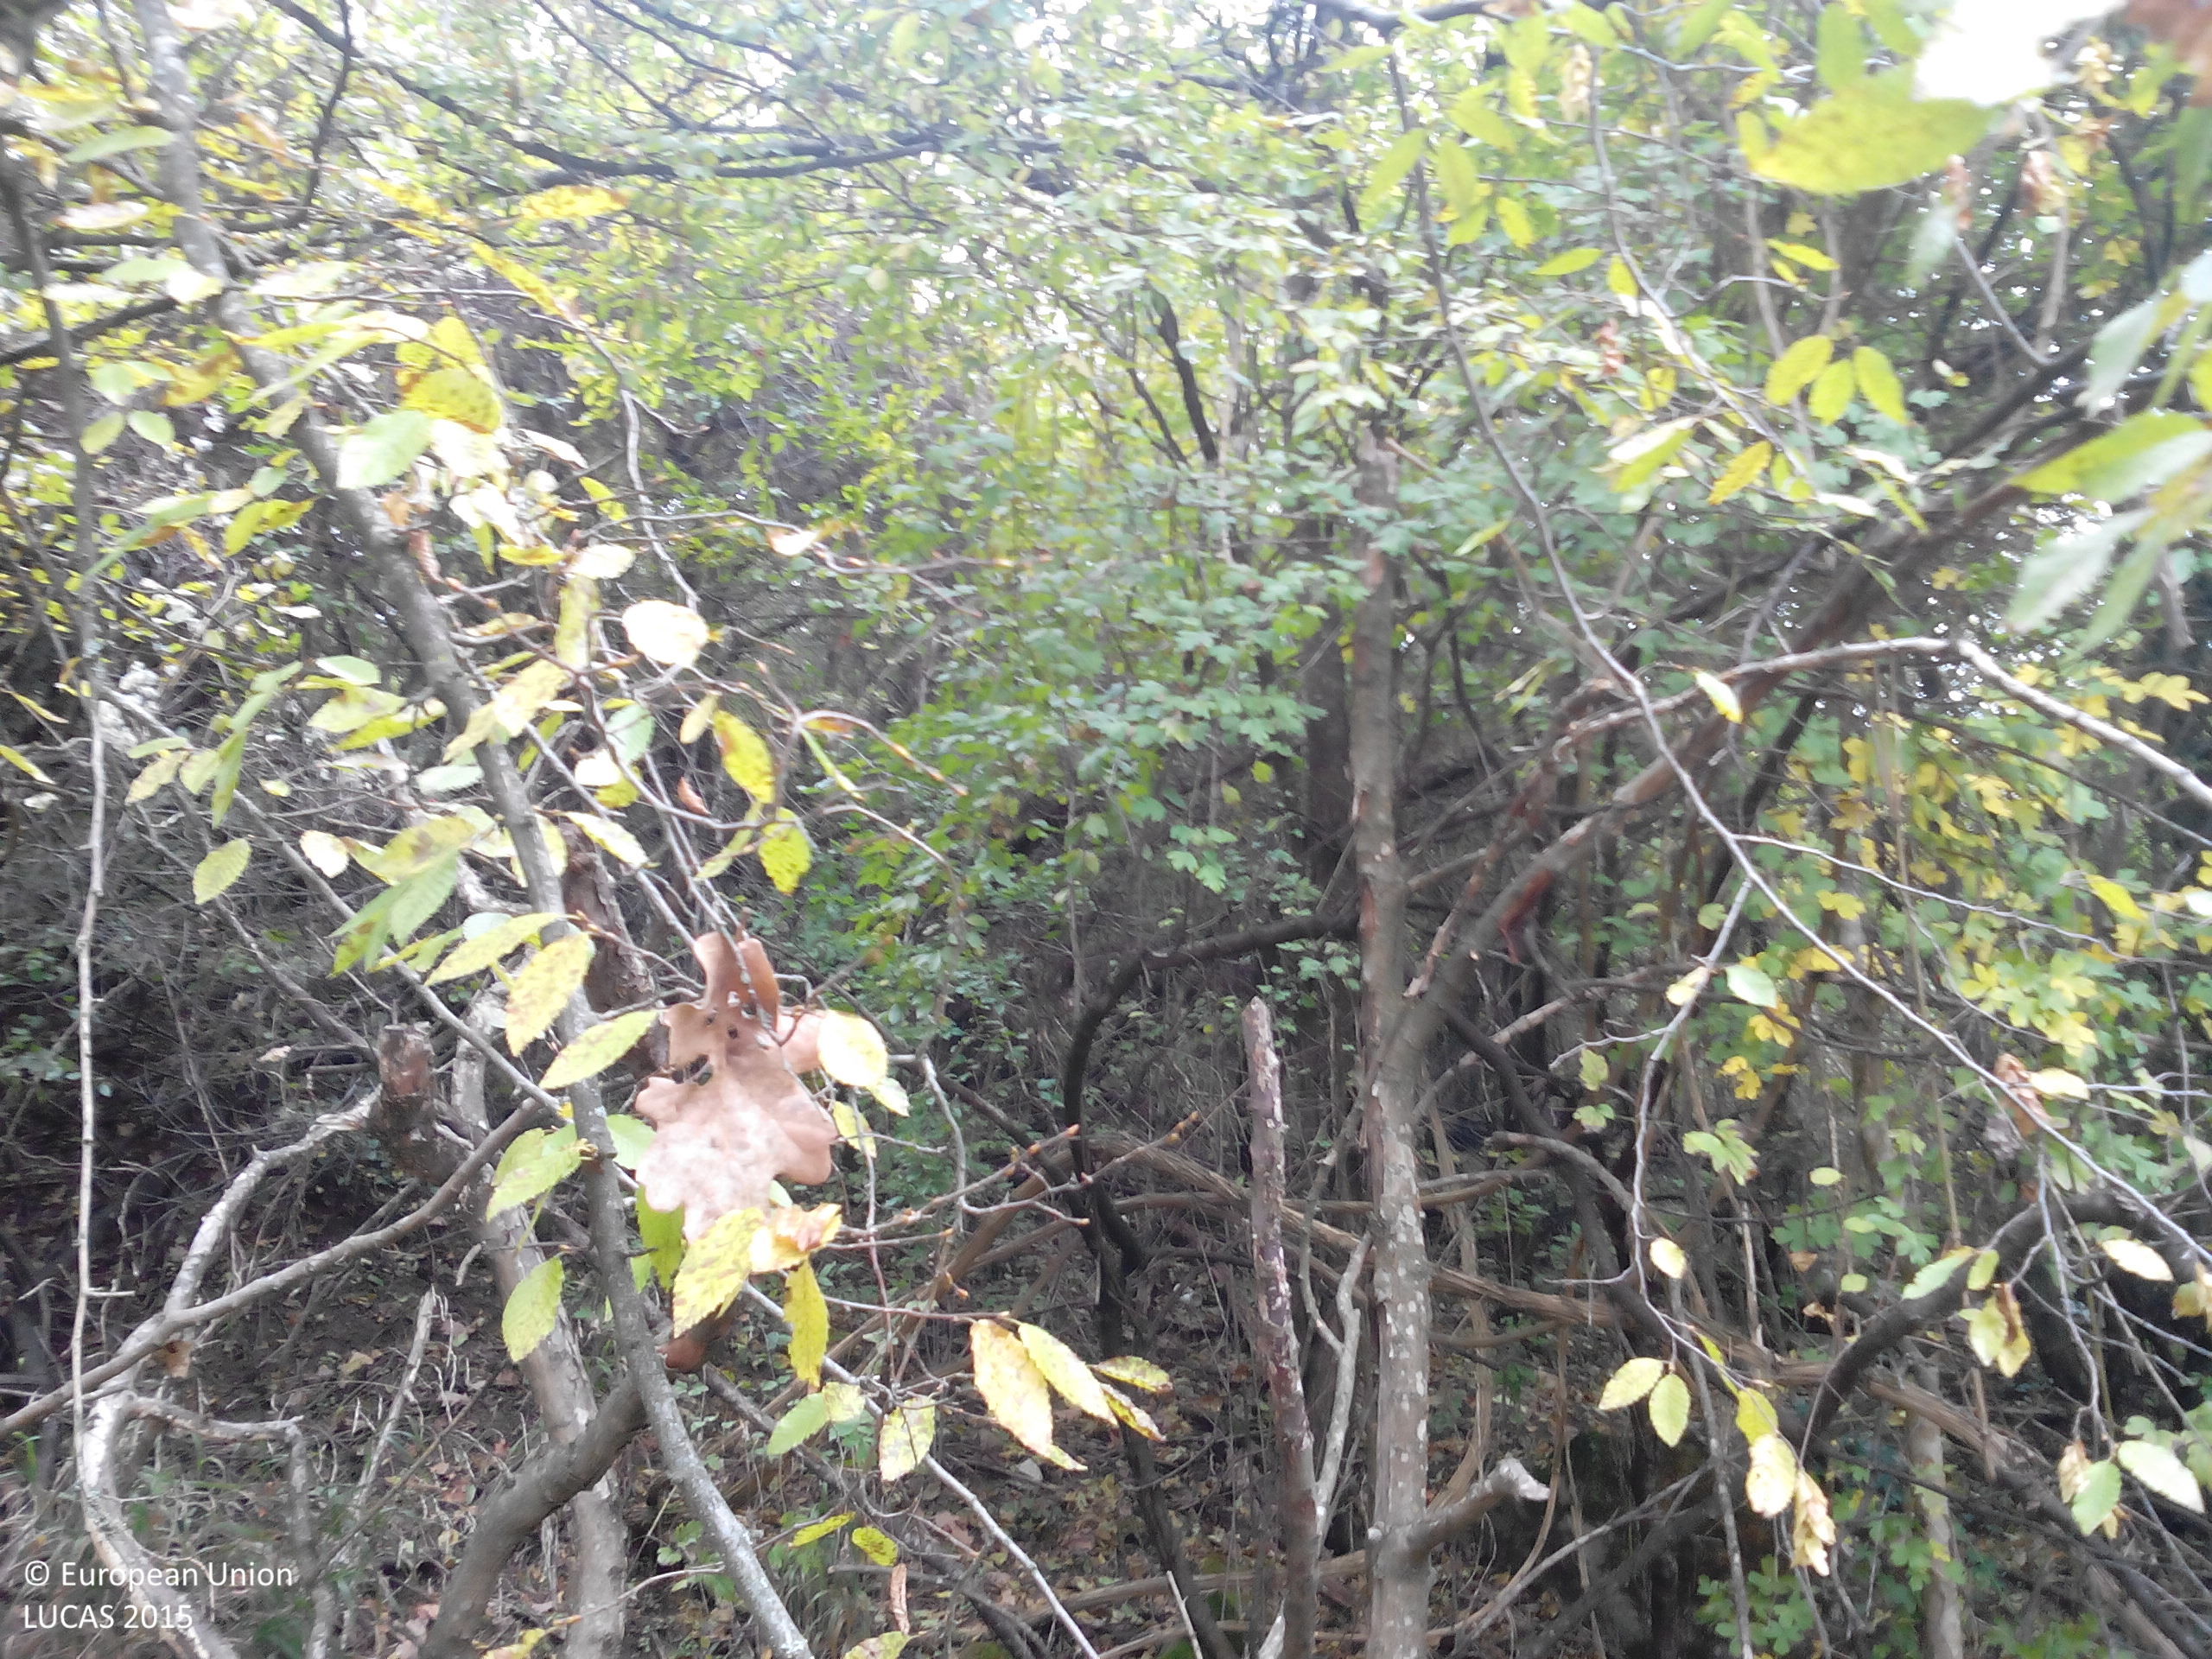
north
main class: Woodland
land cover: Broadleaved woodland
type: mesophytic deciduous forest
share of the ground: > 75 %
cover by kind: broadleaved forest trees 80 %, shrubs 10 %, herbaceous plants 10 %
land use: Abandoned areas
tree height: > 5 m
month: October
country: BG
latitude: 43.0123
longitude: 23.9980
